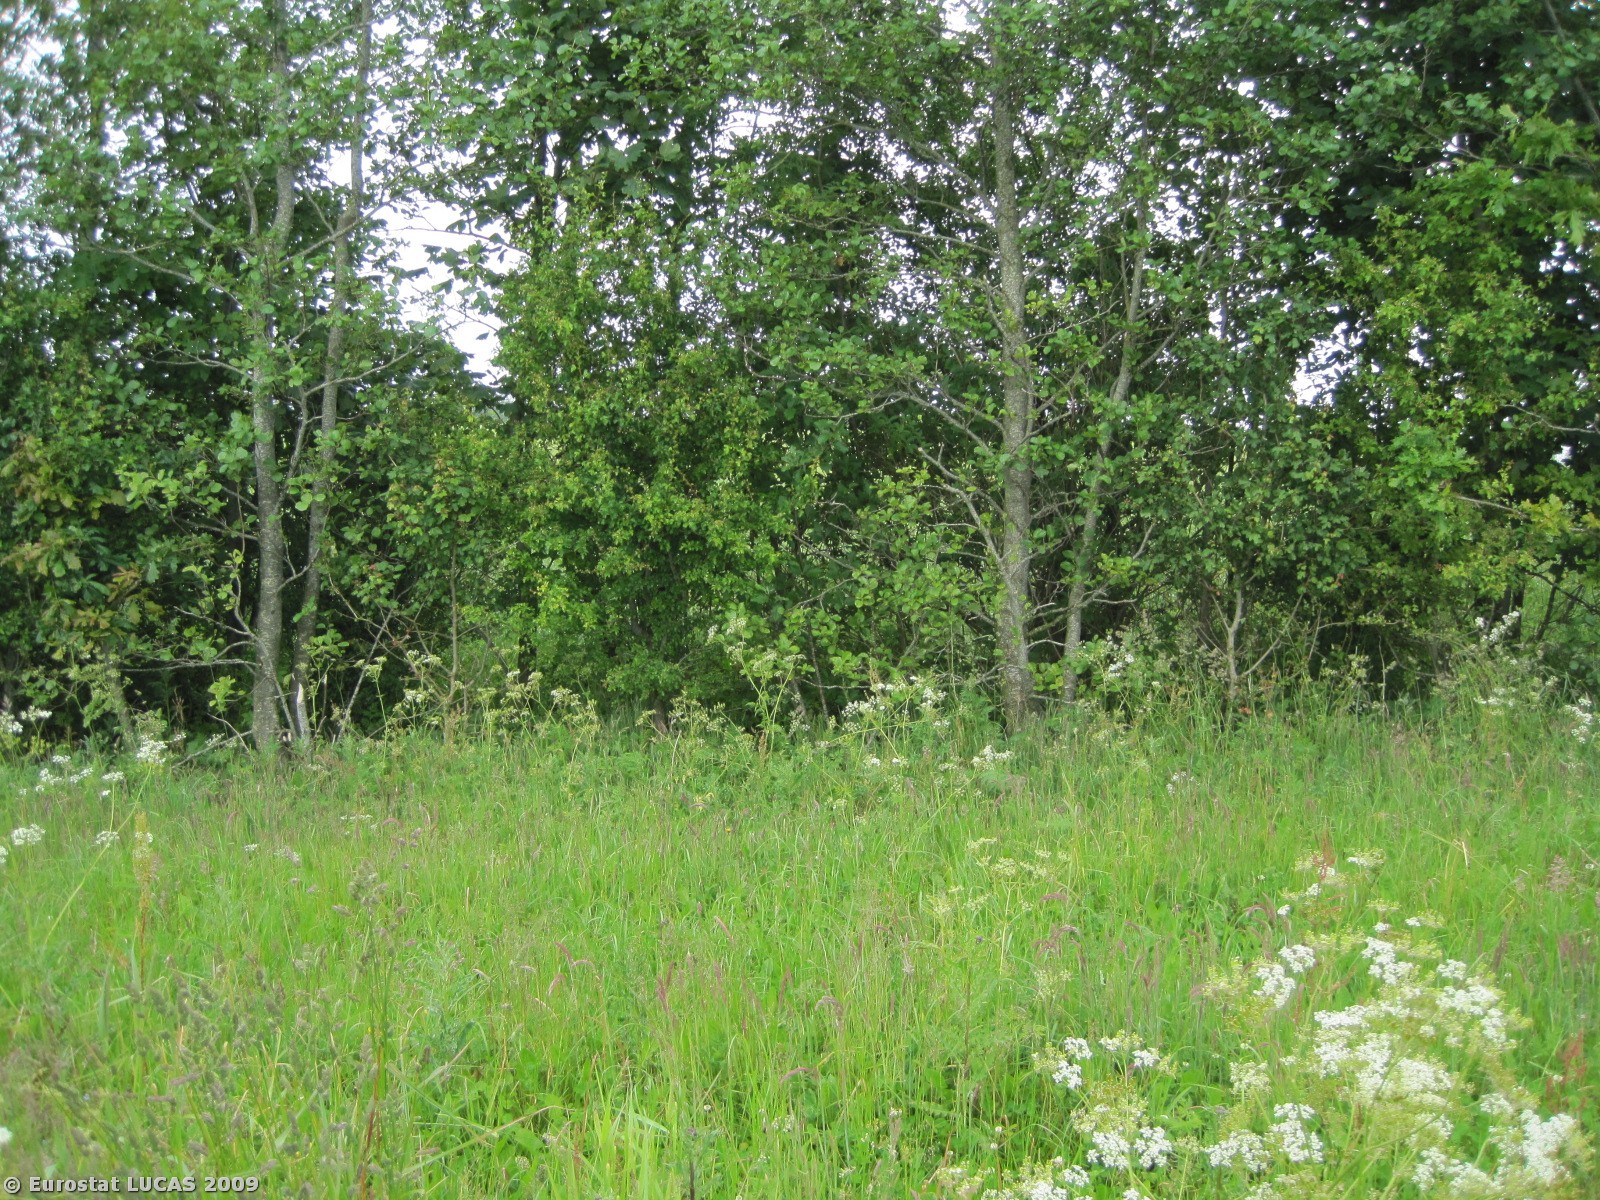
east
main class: Grassland
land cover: Grassland without tree/shrub cover
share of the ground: > 75 %
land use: Unused
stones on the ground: < 10 %
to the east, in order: Grassland without tree/shrub cover; Broadleaved woodland; Grass margins; Rape and turnip rape
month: June
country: DK
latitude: 57.2124
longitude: 10.1157
